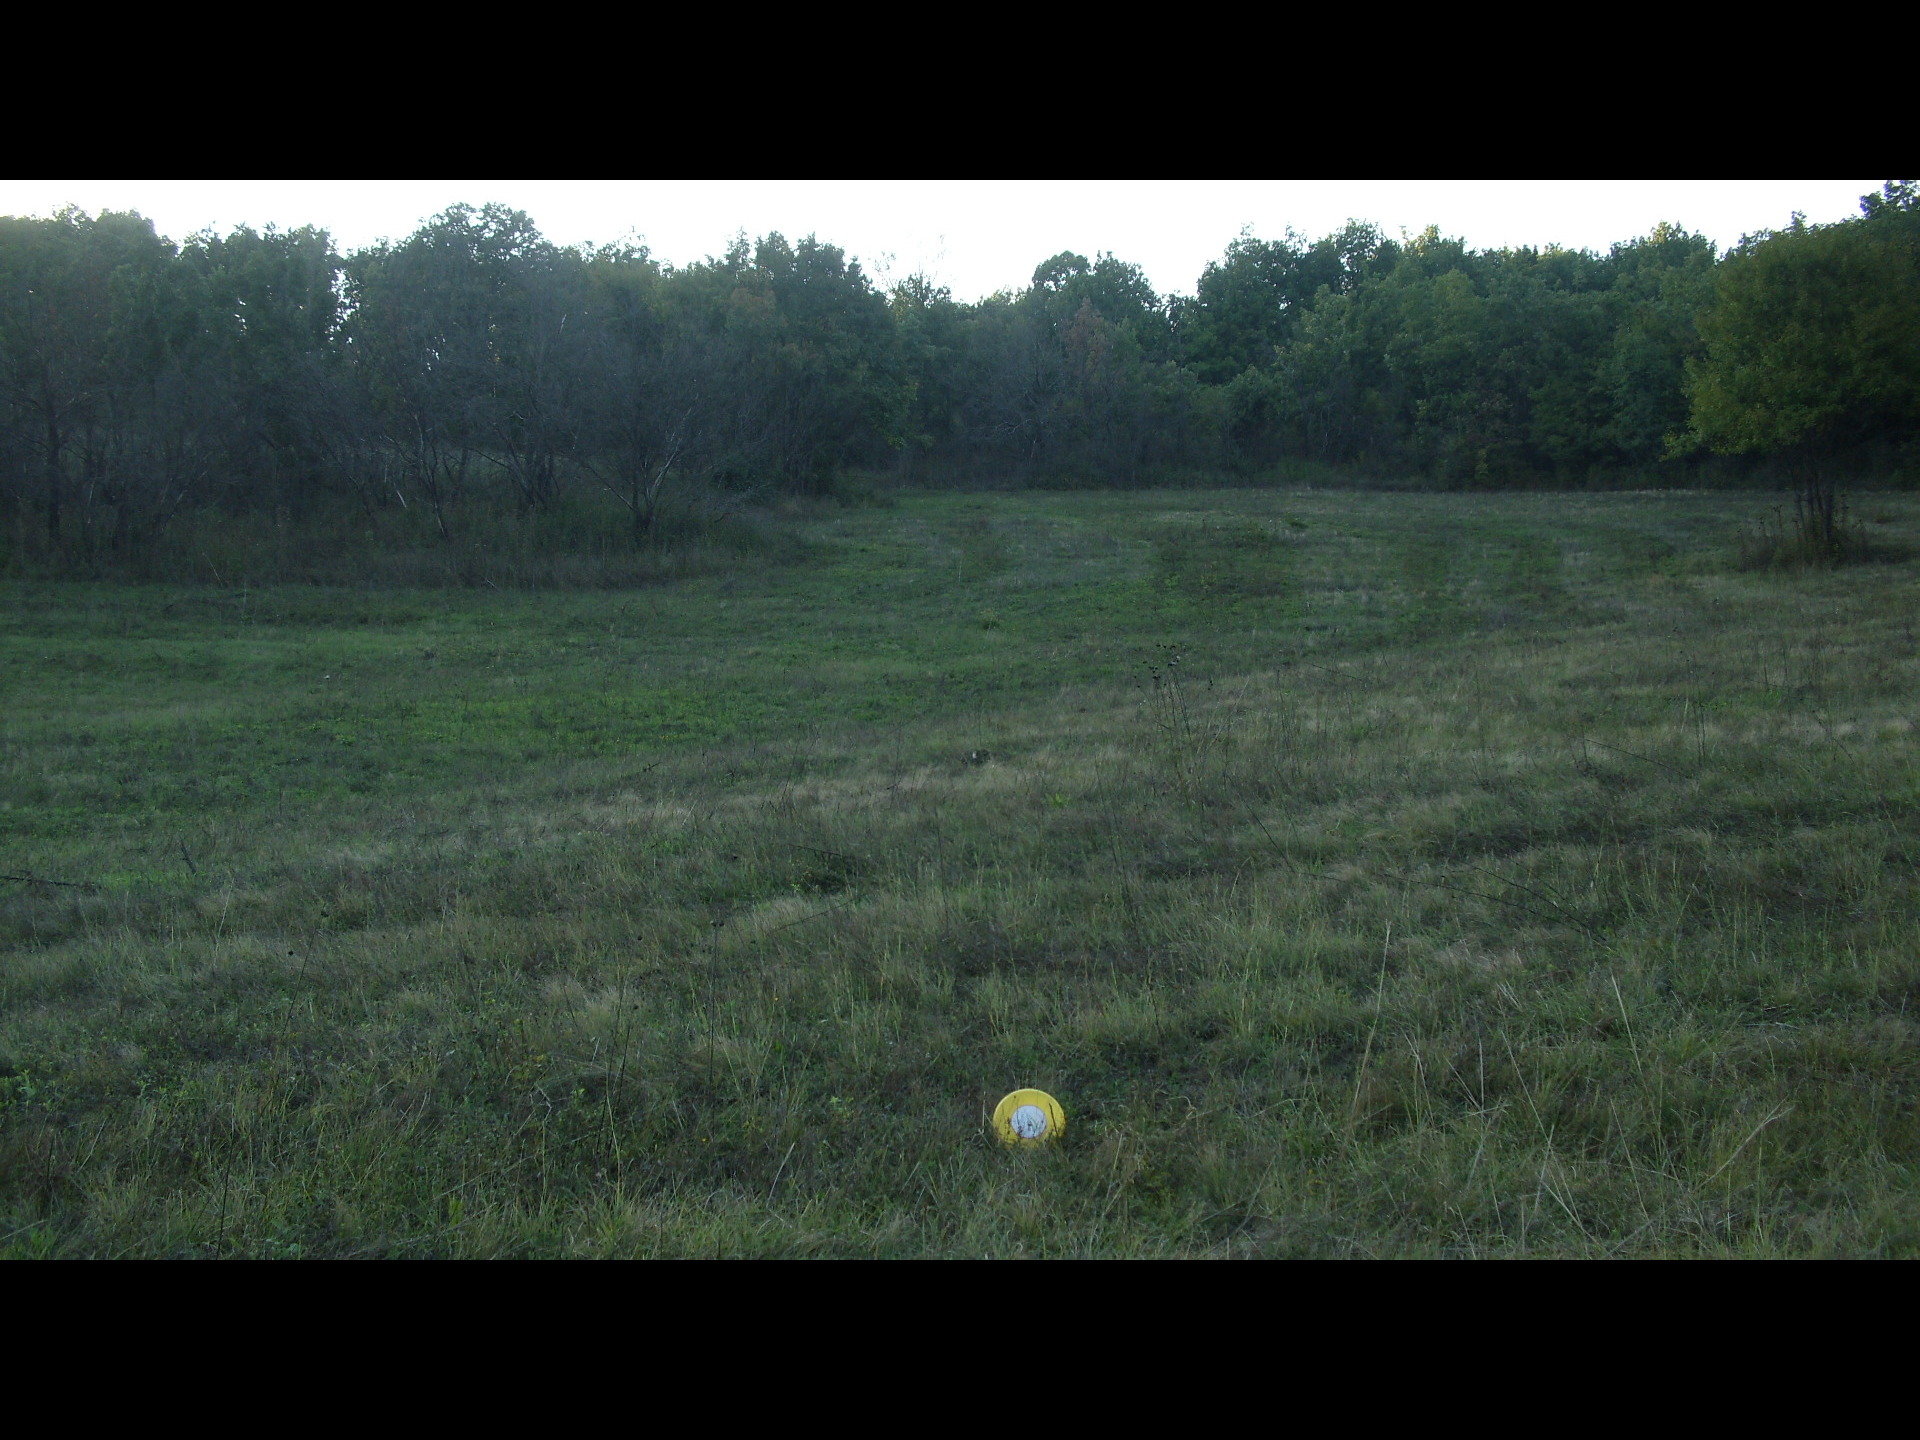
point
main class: Grassland
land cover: Grassland without tree/shrub cover
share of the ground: > 75 %
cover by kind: herbaceous plants 100 %
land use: Agriculture (excluding fallow land and kitchen gardens)
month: October
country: BG
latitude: 43.4349
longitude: 23.0212
